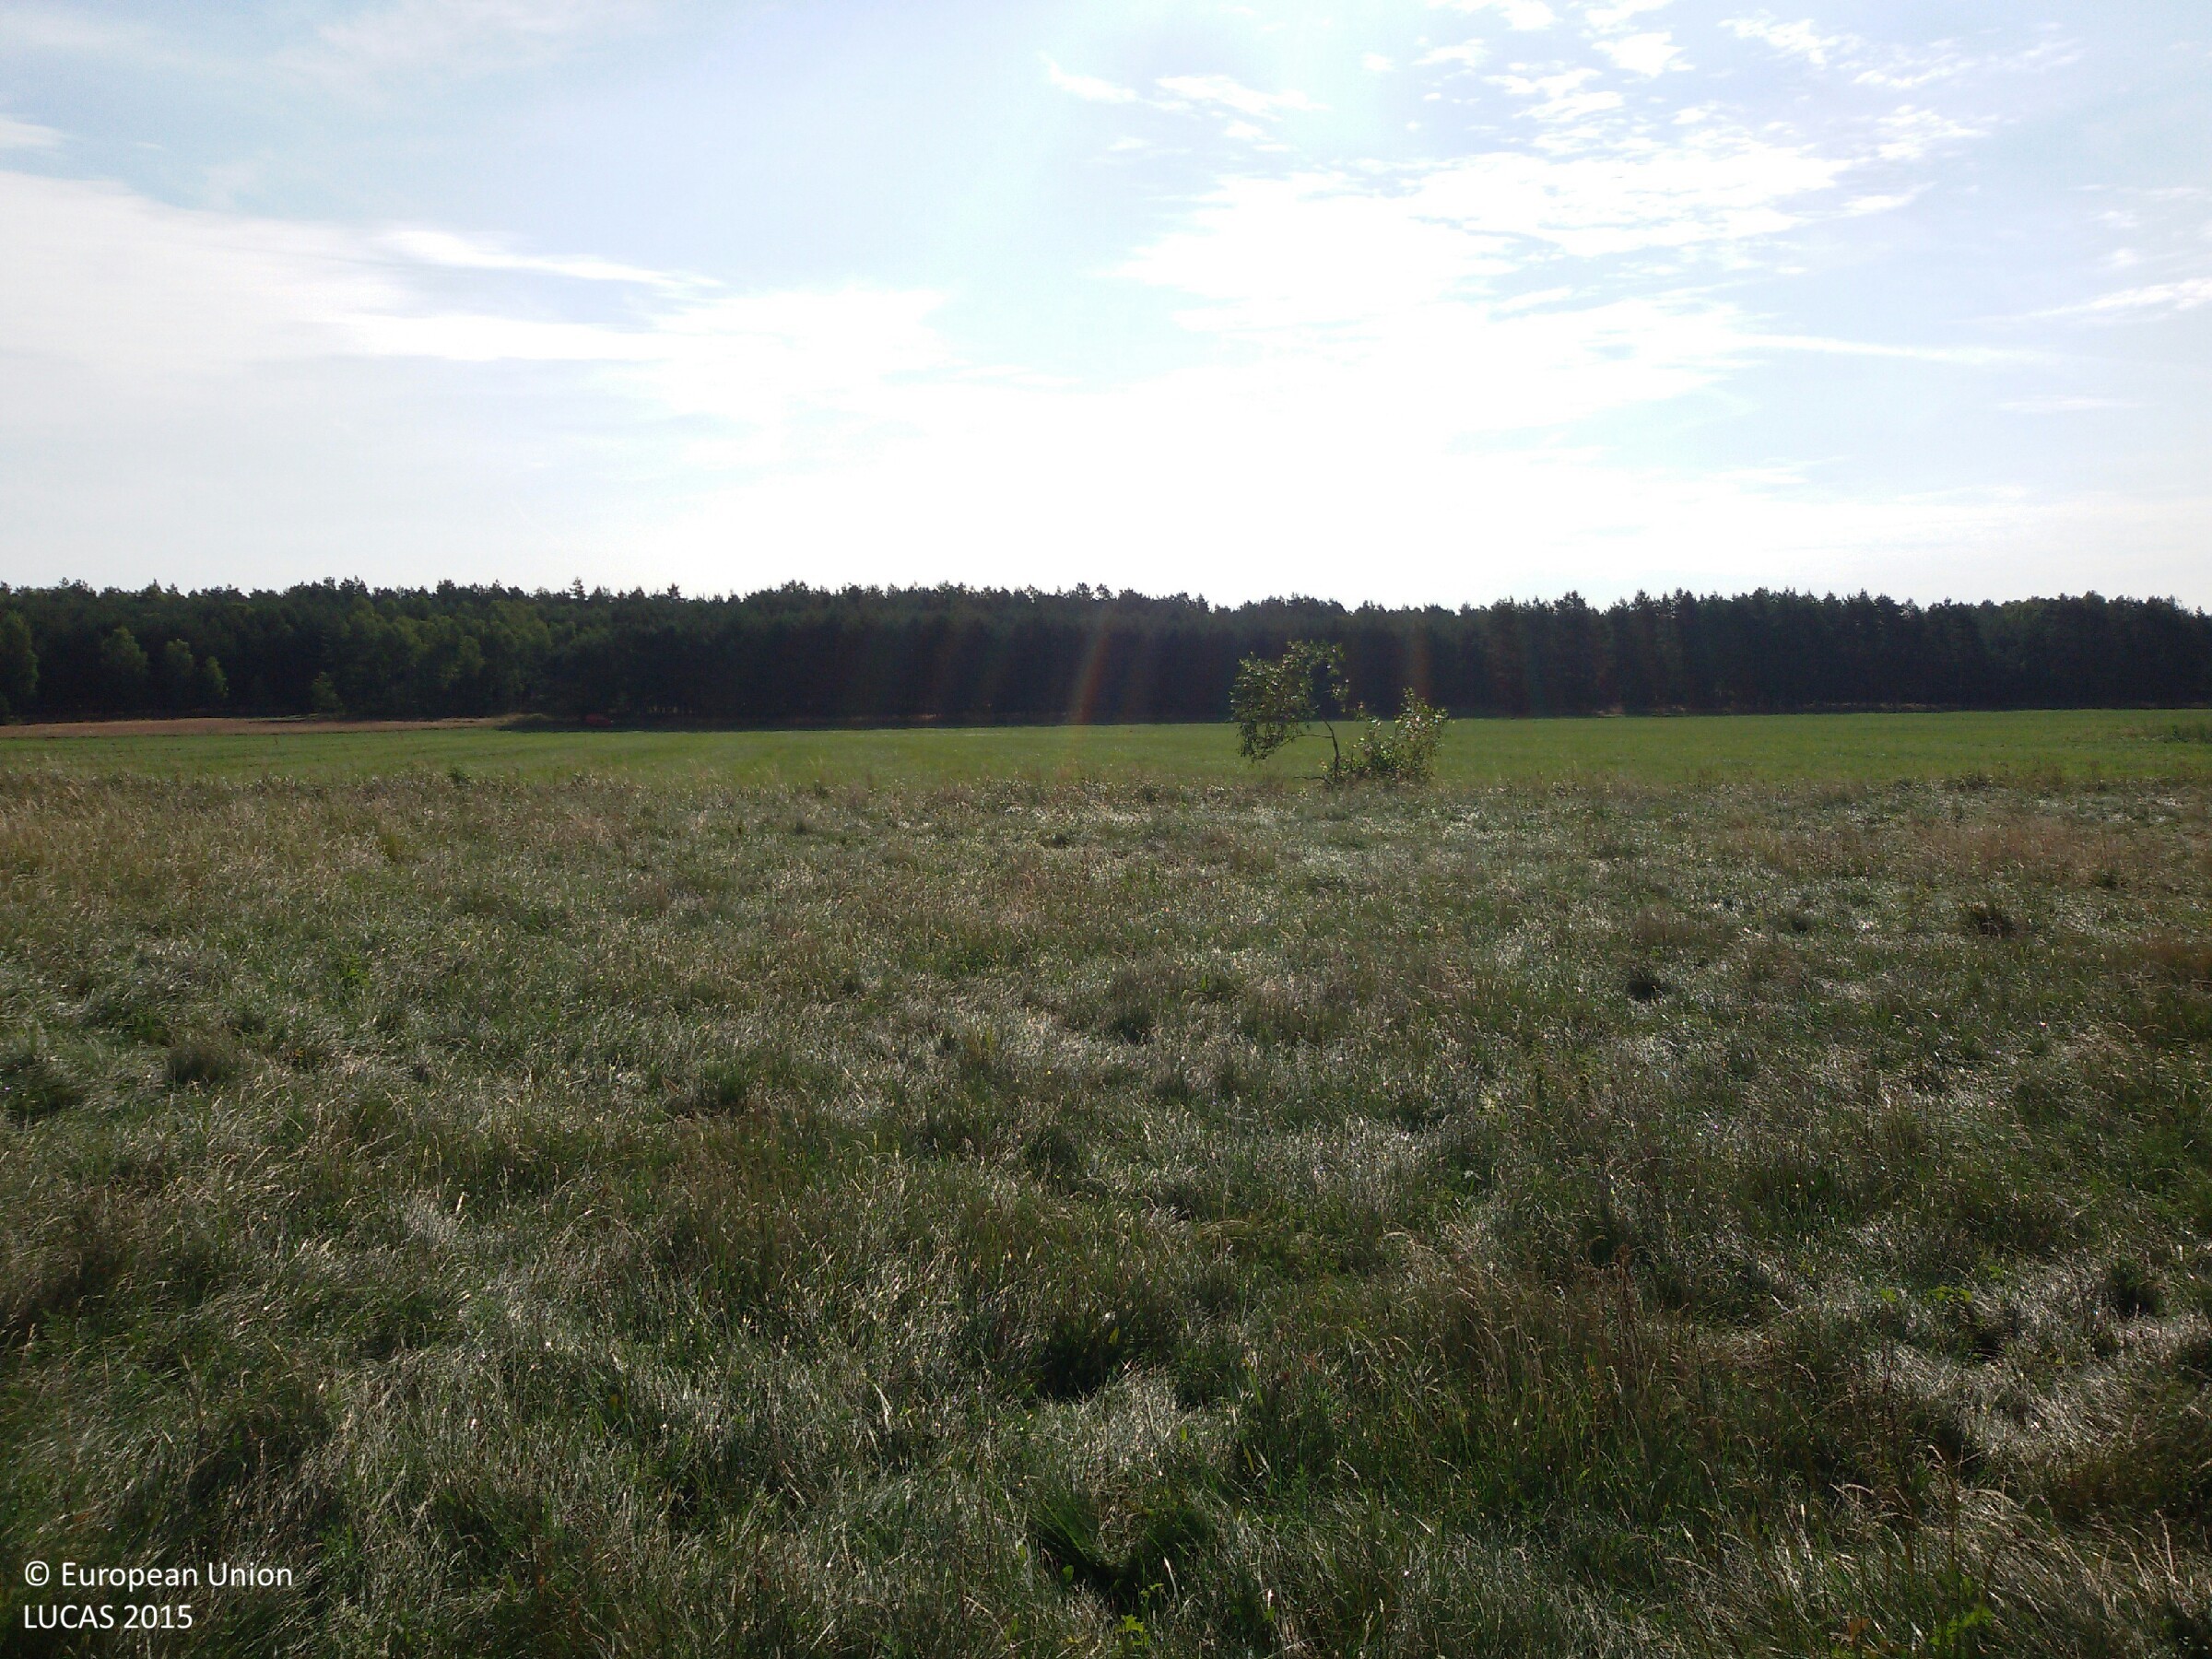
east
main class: Grassland
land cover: Grassland without tree/shrub cover
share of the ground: > 75 %
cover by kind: herbaceous plants 100 %
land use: Agriculture (excluding fallow land and kitchen gardens)
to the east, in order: Grassland without tree/shrub cover; Ditches and canals; Grassland without tree/shrub cover
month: July
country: PL
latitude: 53.1416
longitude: 15.7000
